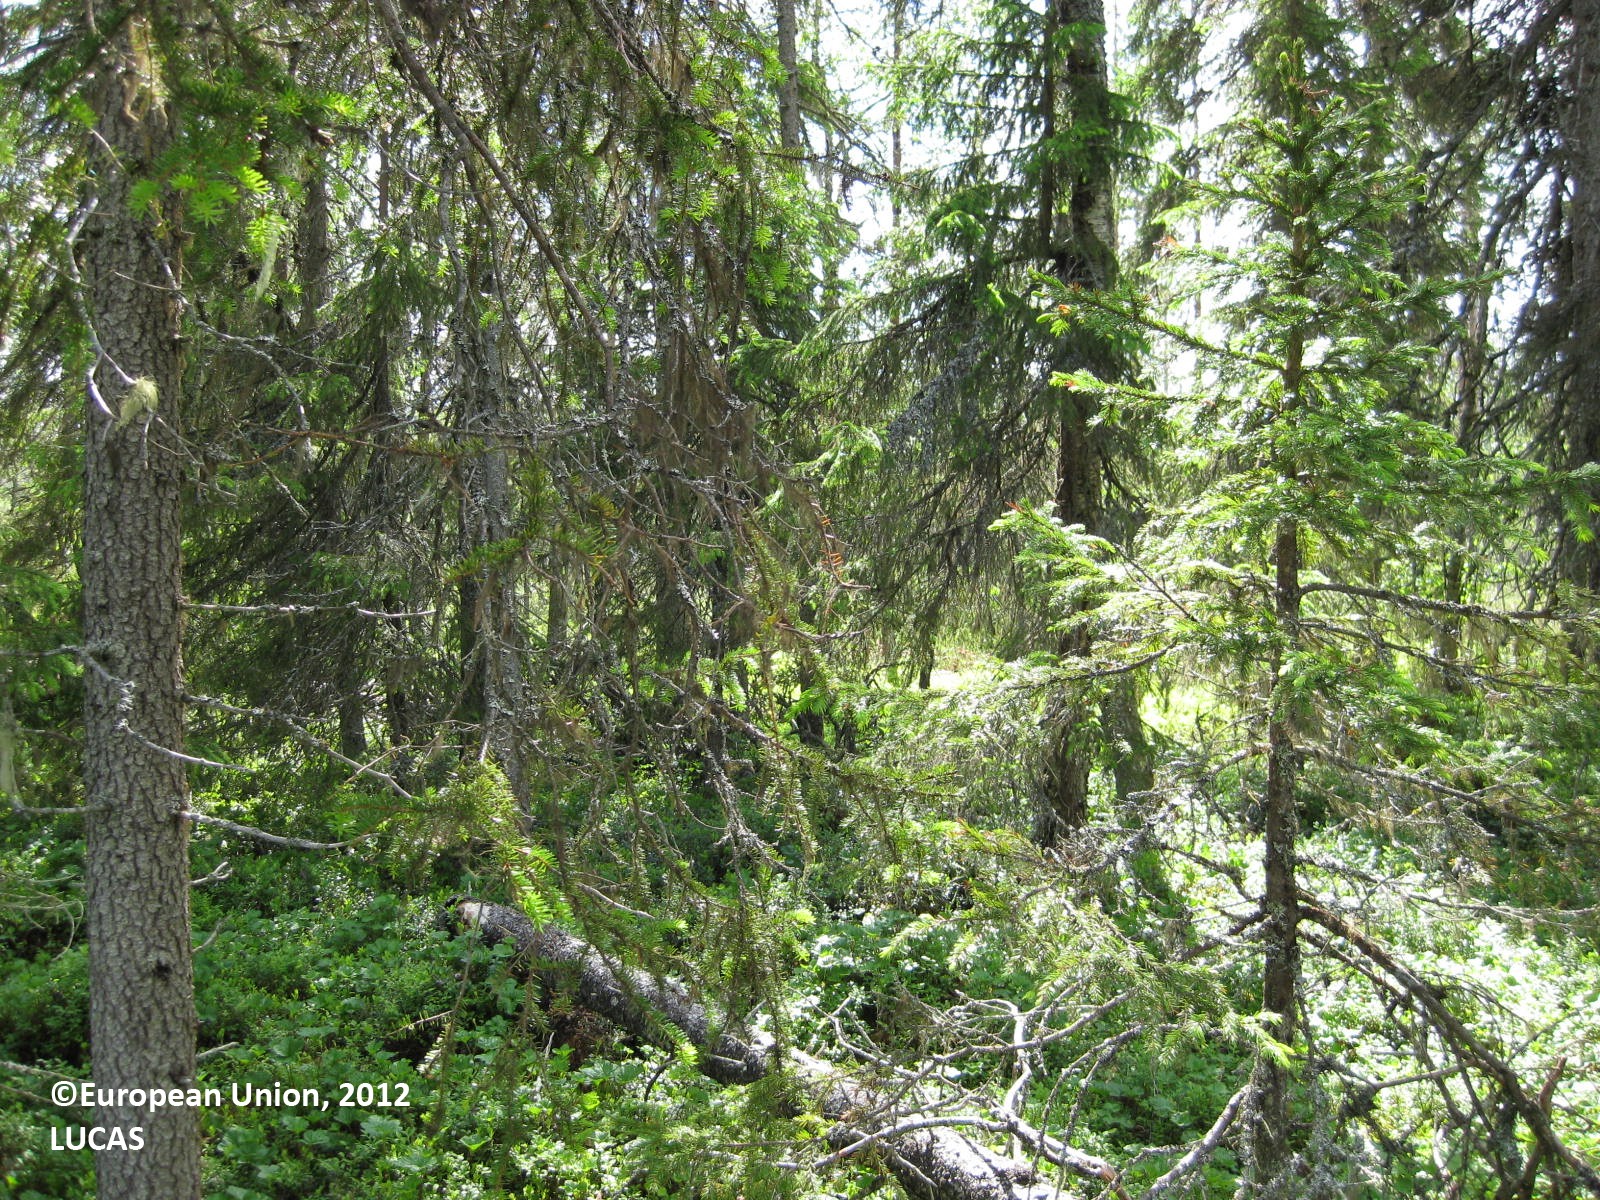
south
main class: Woodland
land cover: Spruce dominated coniferous woodland
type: boreal forest
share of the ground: > 75 %
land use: Forestry
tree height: > 5 m
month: July
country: FI
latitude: 65.6379
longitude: 29.5561
